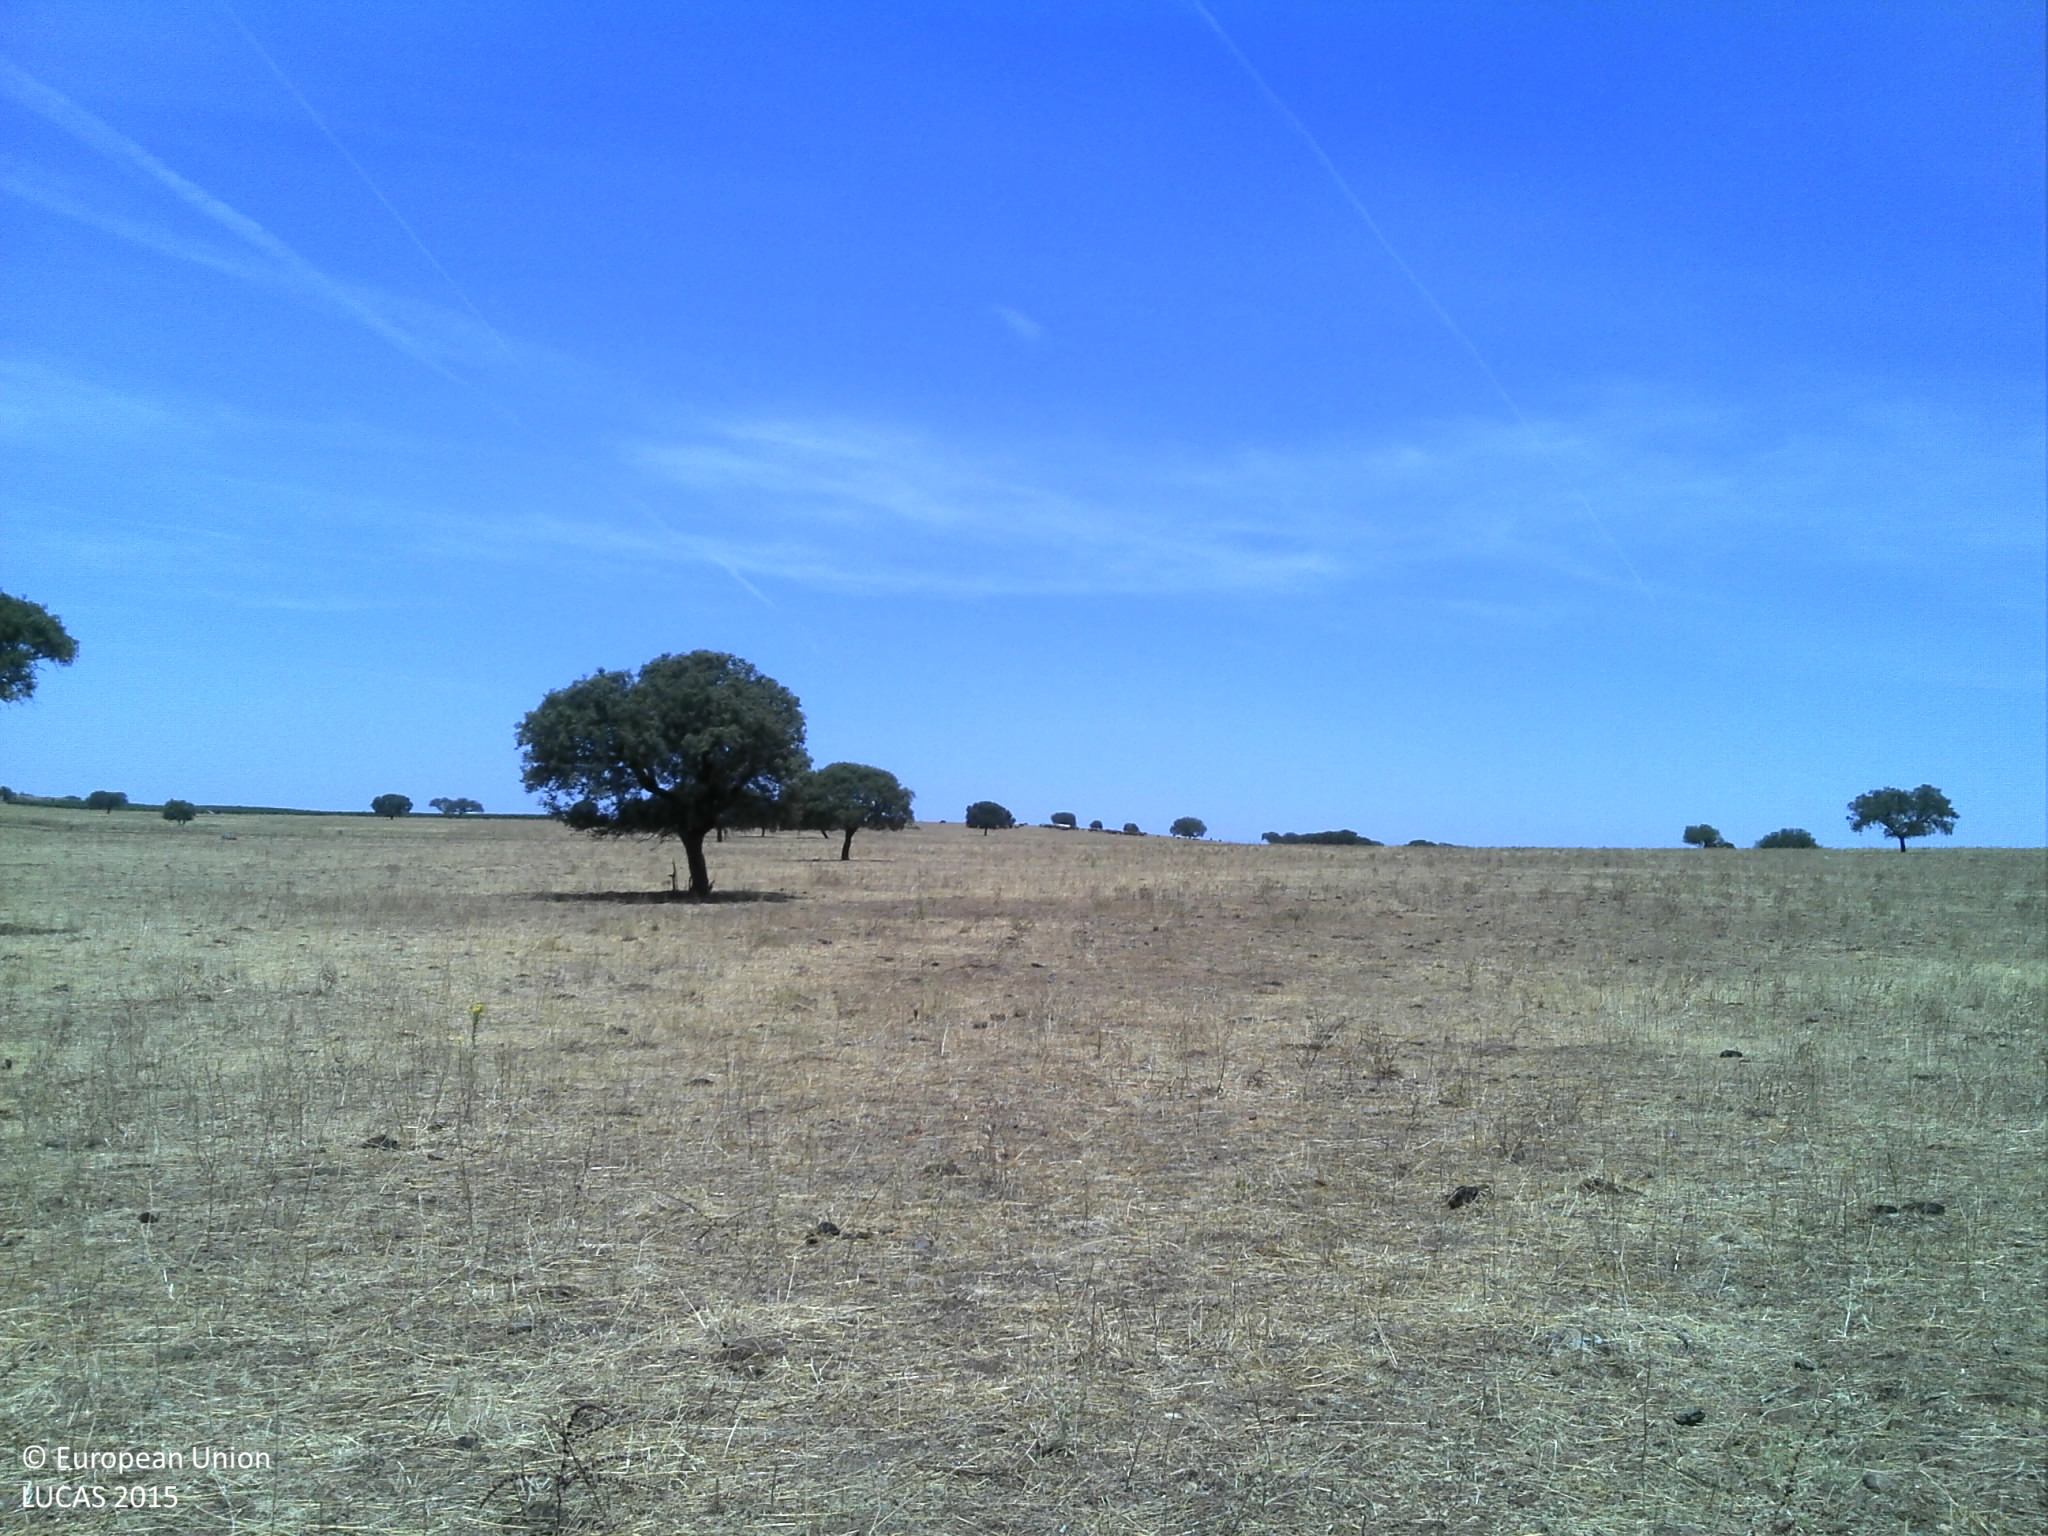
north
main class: Grassland
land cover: Spontaneously vegetated surfaces
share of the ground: 10 - 25 %
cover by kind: unconsolidated bare surface 90 %, herbaceous plants 10 %
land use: Agriculture (excluding fallow land and kitchen gardens)
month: July
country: PT
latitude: 38.3743
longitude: -7.4583
